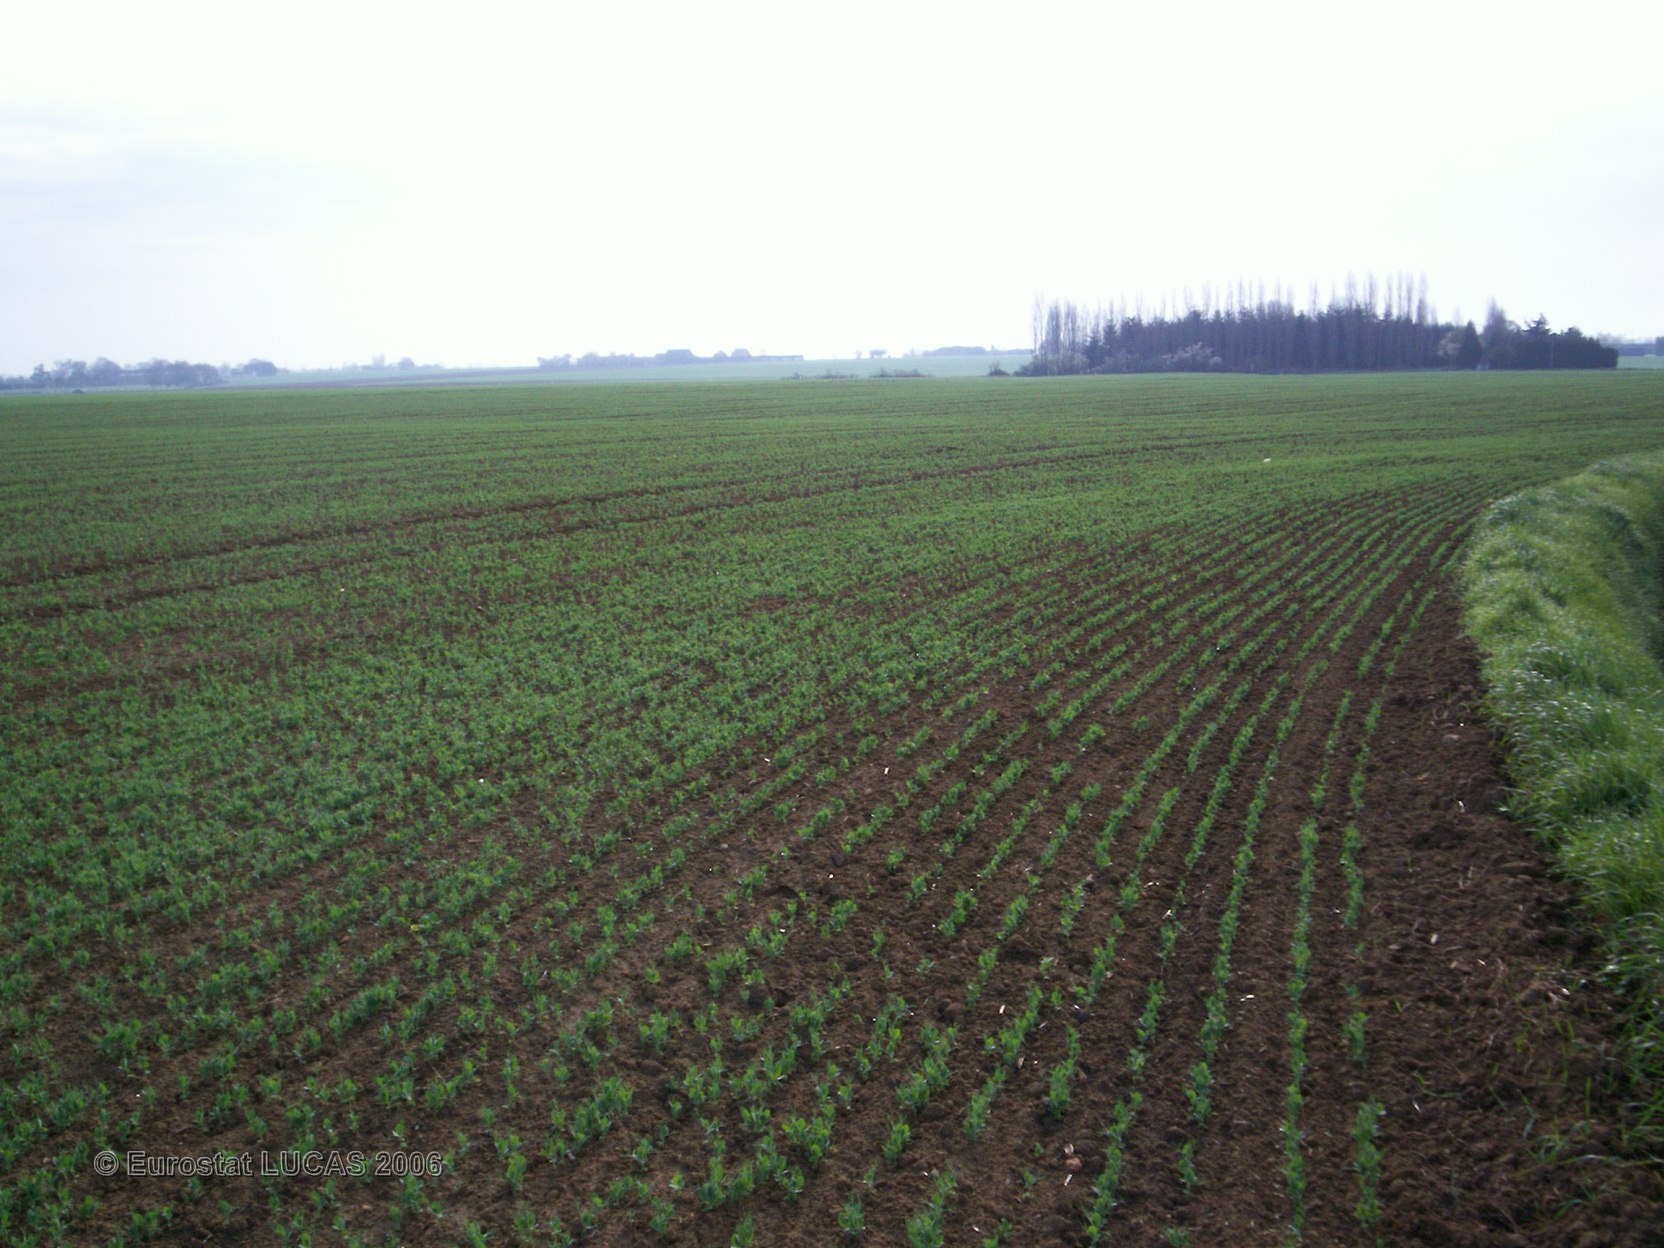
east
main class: Cropland
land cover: Dry pulses
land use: Agriculture (excluding fallow land and kitchen gardens)
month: April
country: FR
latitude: 48.2246
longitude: 0.2413
